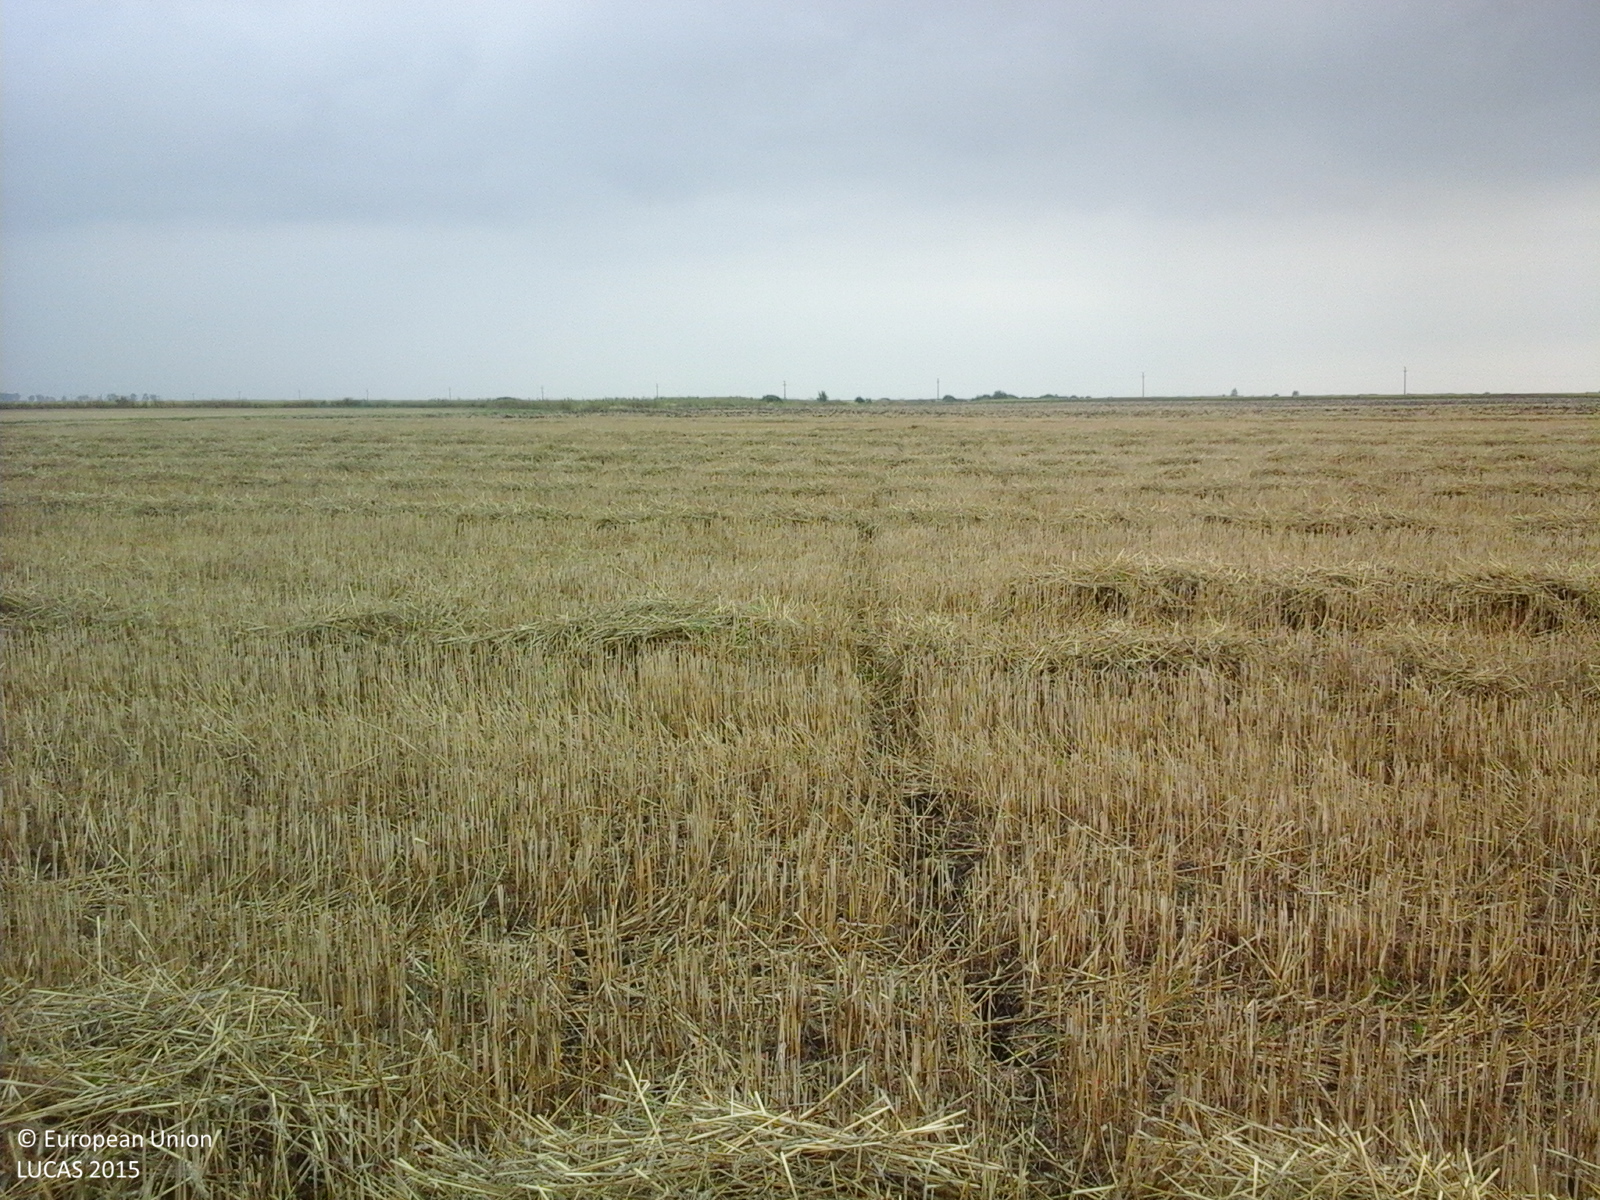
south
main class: Cropland
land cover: Common wheat
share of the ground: < 10 %
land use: Agriculture (excluding fallow land and kitchen gardens)
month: August
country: RO
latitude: 46.1571
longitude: 20.5269
